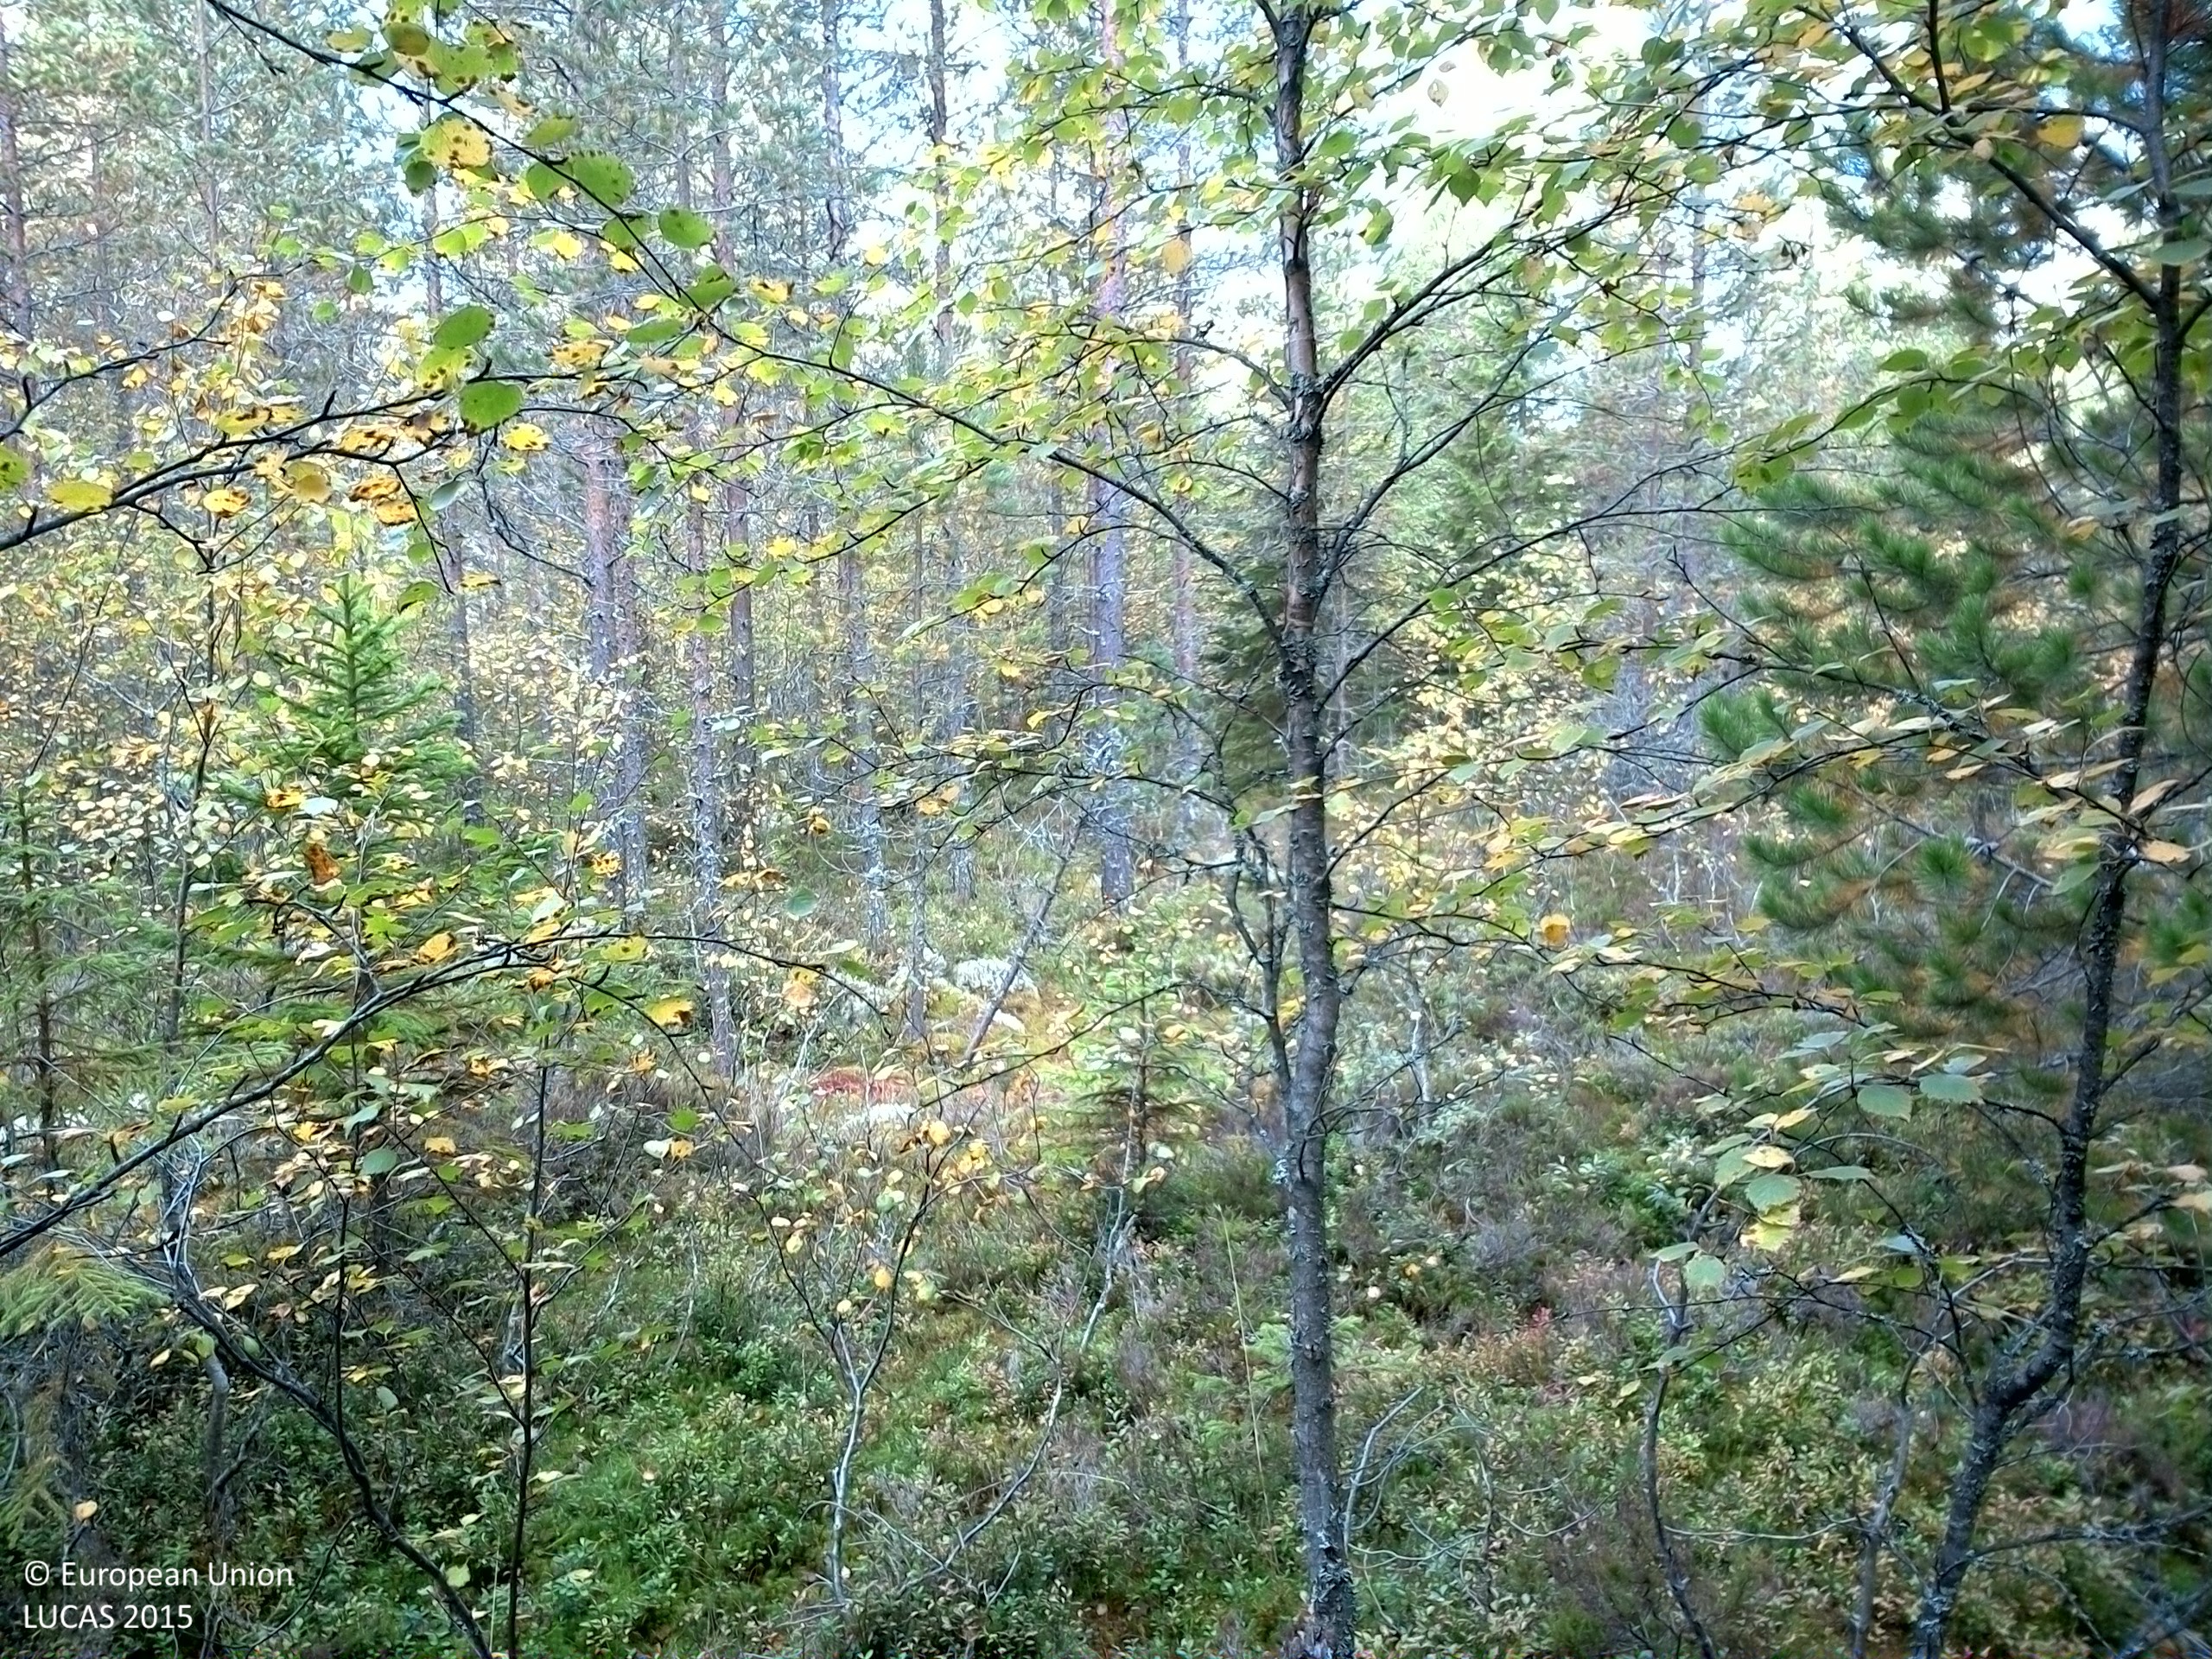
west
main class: Woodland
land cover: Pine dominated mixed woodland
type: exotic forest
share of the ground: 50 - 75 %
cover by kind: coniferous forest trees 50 %, broadleaved forest trees 20 %, shrubs 20 %, lichens and mosses 10 %
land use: Forestry
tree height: > 5 m
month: September
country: SE
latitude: 61.3609
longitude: 15.3524
